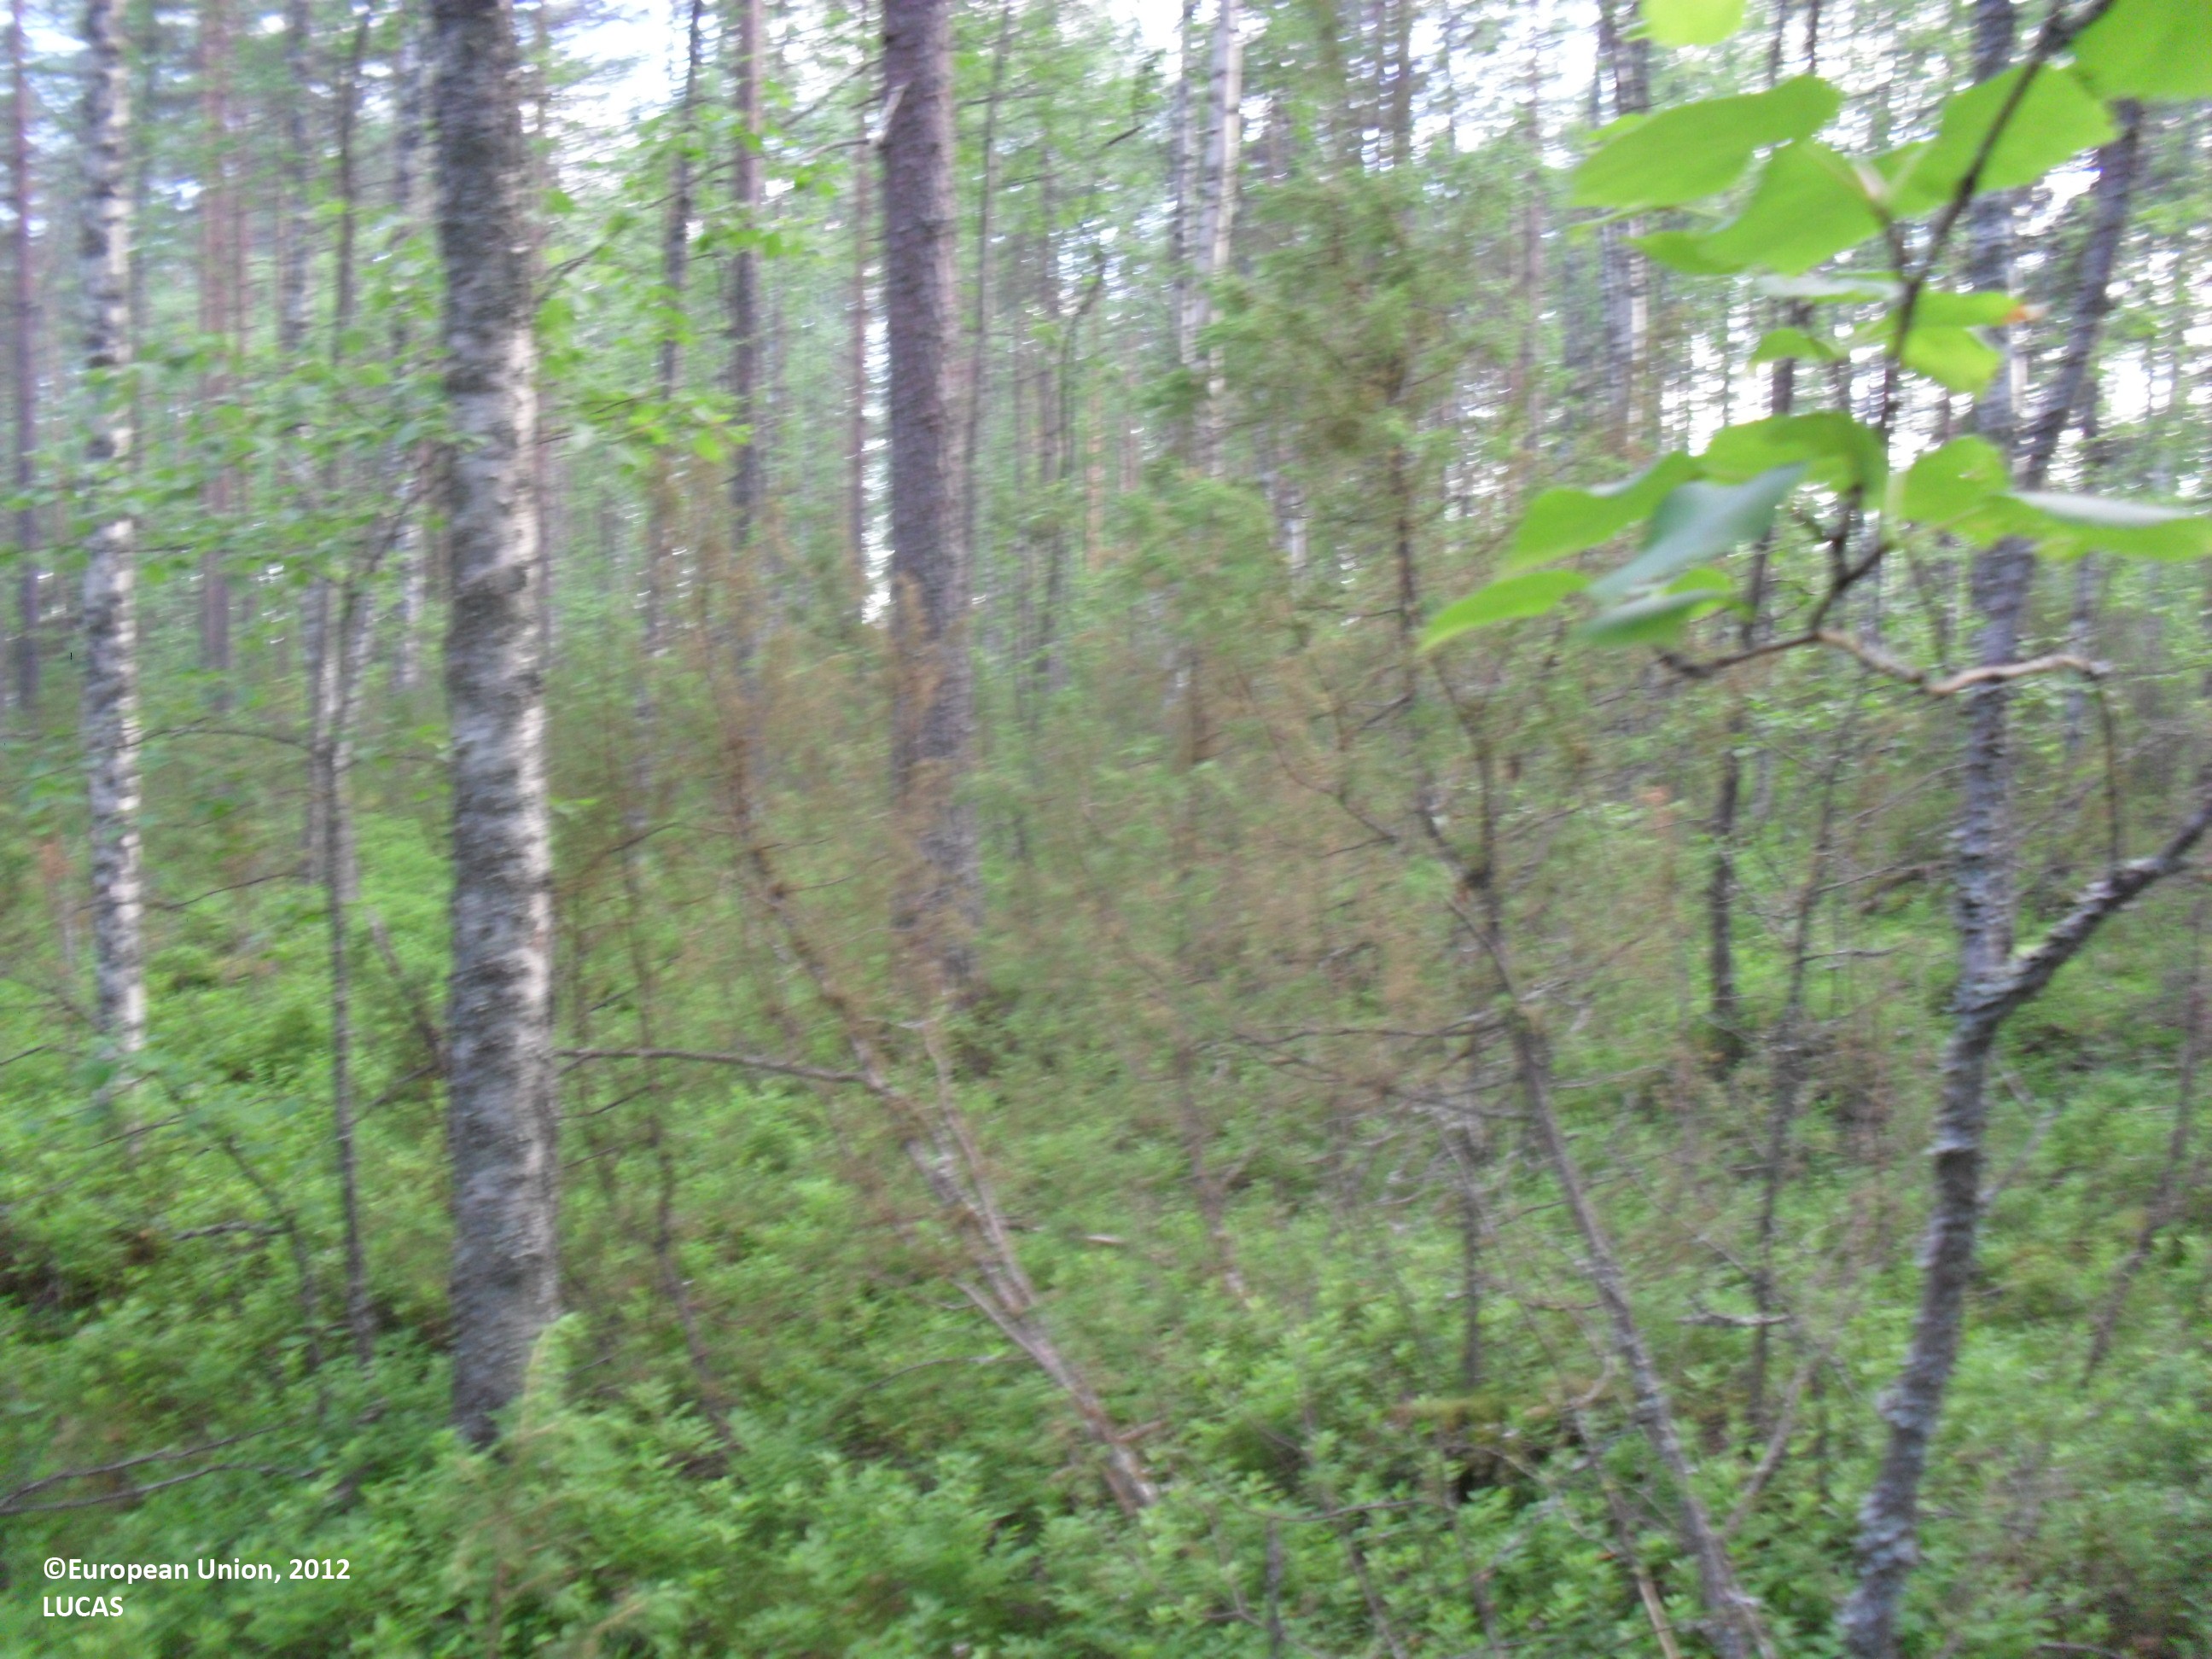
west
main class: Woodland
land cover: Other mixed woodland
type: boreal forest
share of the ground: 50 - 75 %
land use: Forestry
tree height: > 5 m
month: July
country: FI
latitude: 63.0467
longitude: 24.2989
